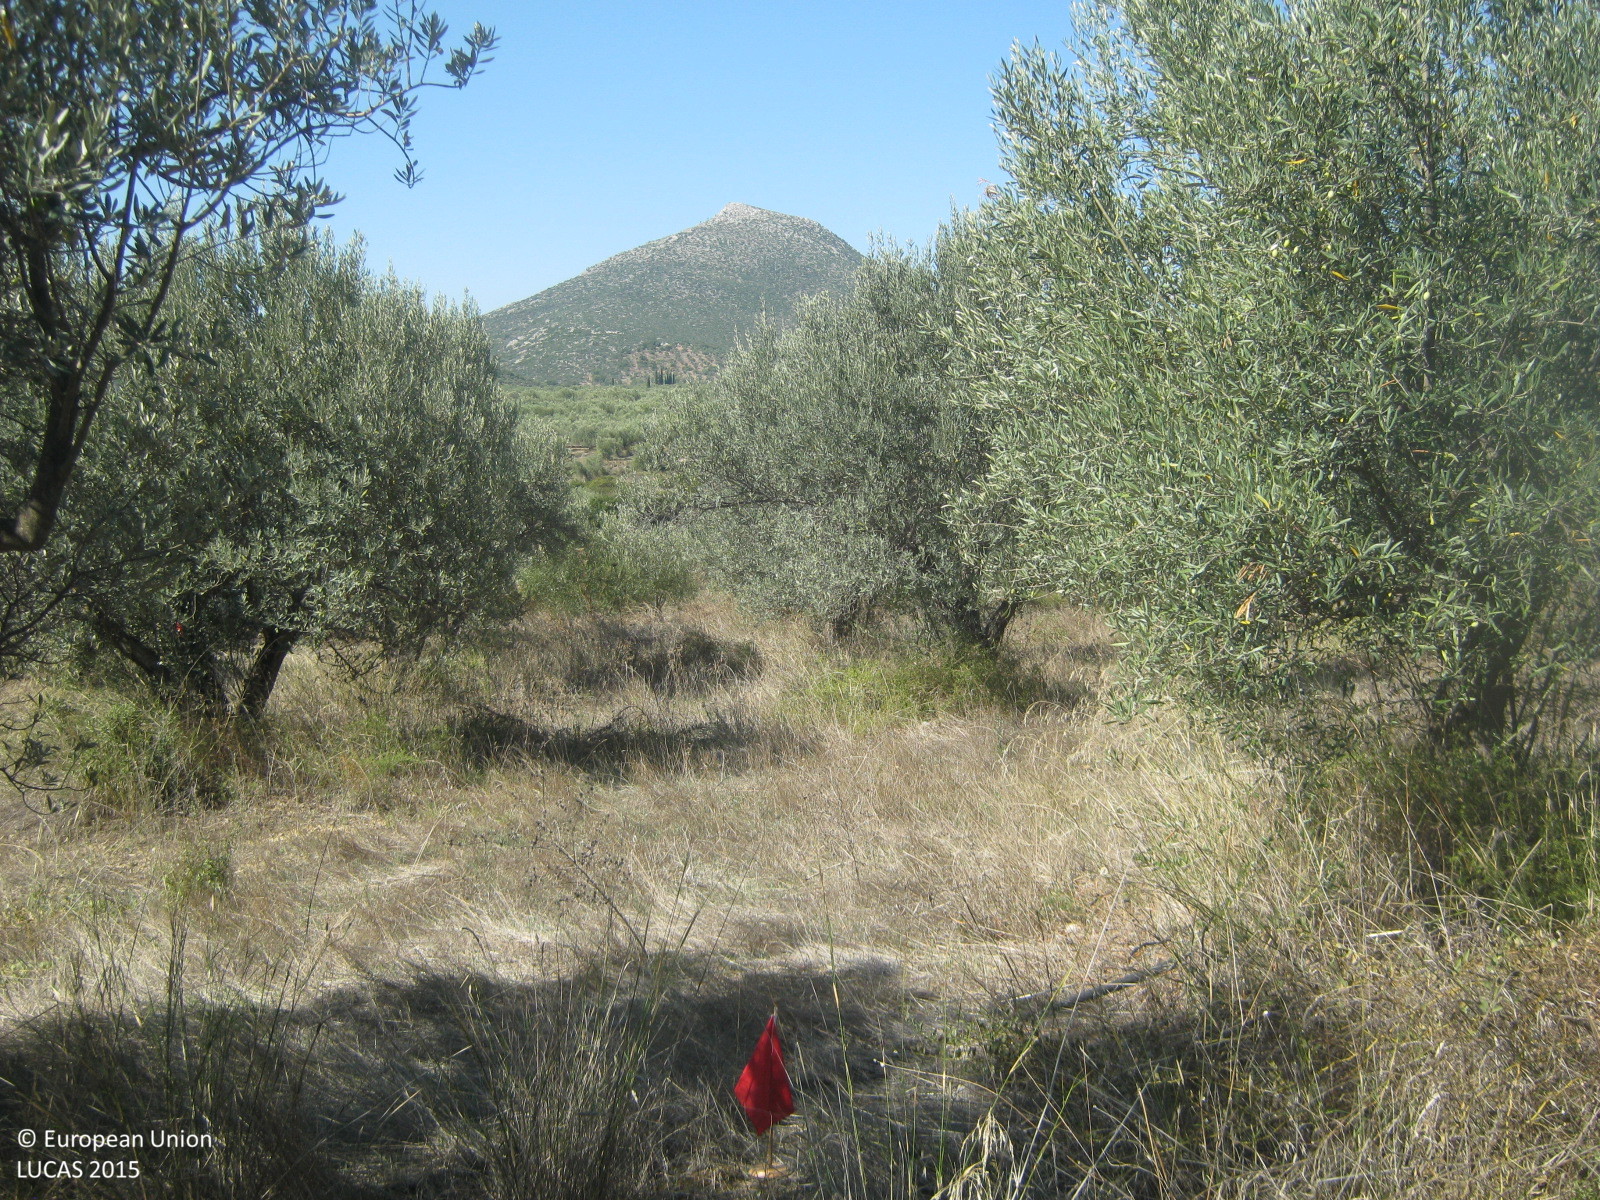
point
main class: Cropland
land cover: Olive groves
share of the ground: > 75 %
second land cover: Spontaneously vegetated surfaces
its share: 25 - 50 %
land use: Agriculture (excluding fallow land and kitchen gardens)
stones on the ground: 10 - 25 %
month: October
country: GR
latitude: 37.7221
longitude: 22.7994
